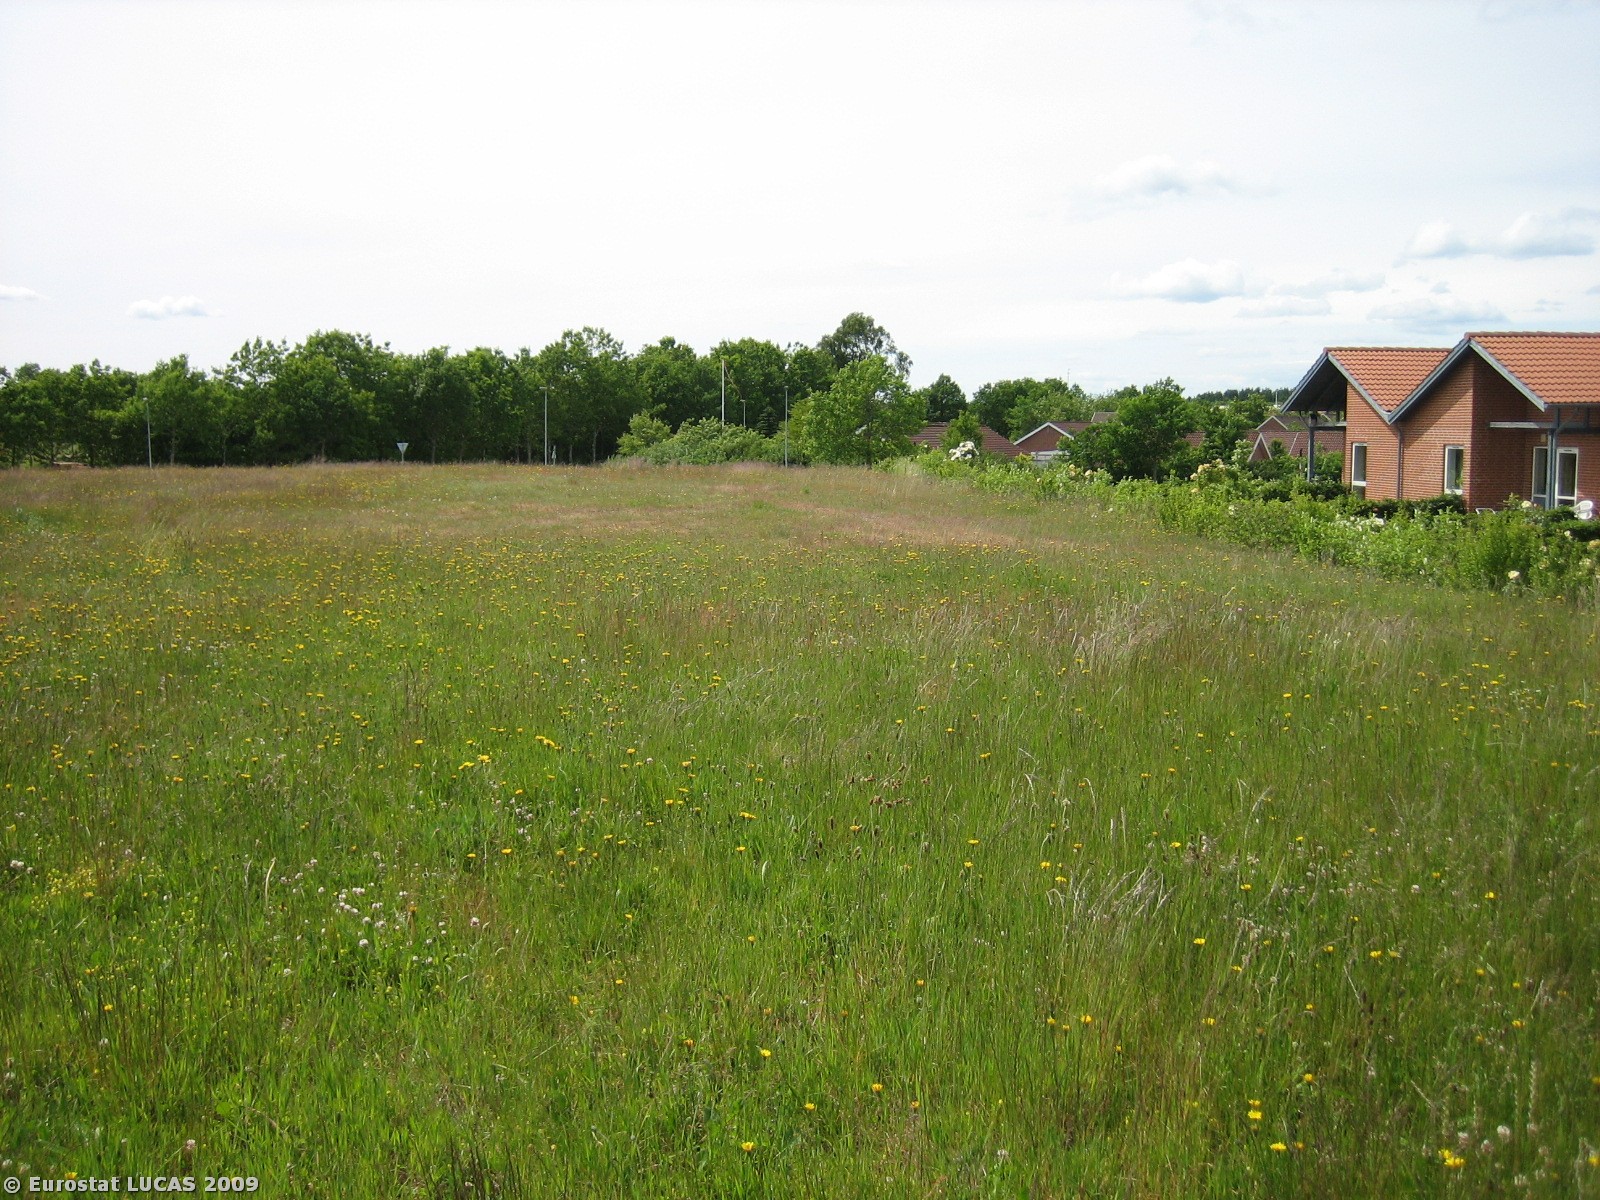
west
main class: Grassland
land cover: Grassland without tree/shrub cover
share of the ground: > 75 %
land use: Unused
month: June
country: DK
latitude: 56.1874
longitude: 9.6942
